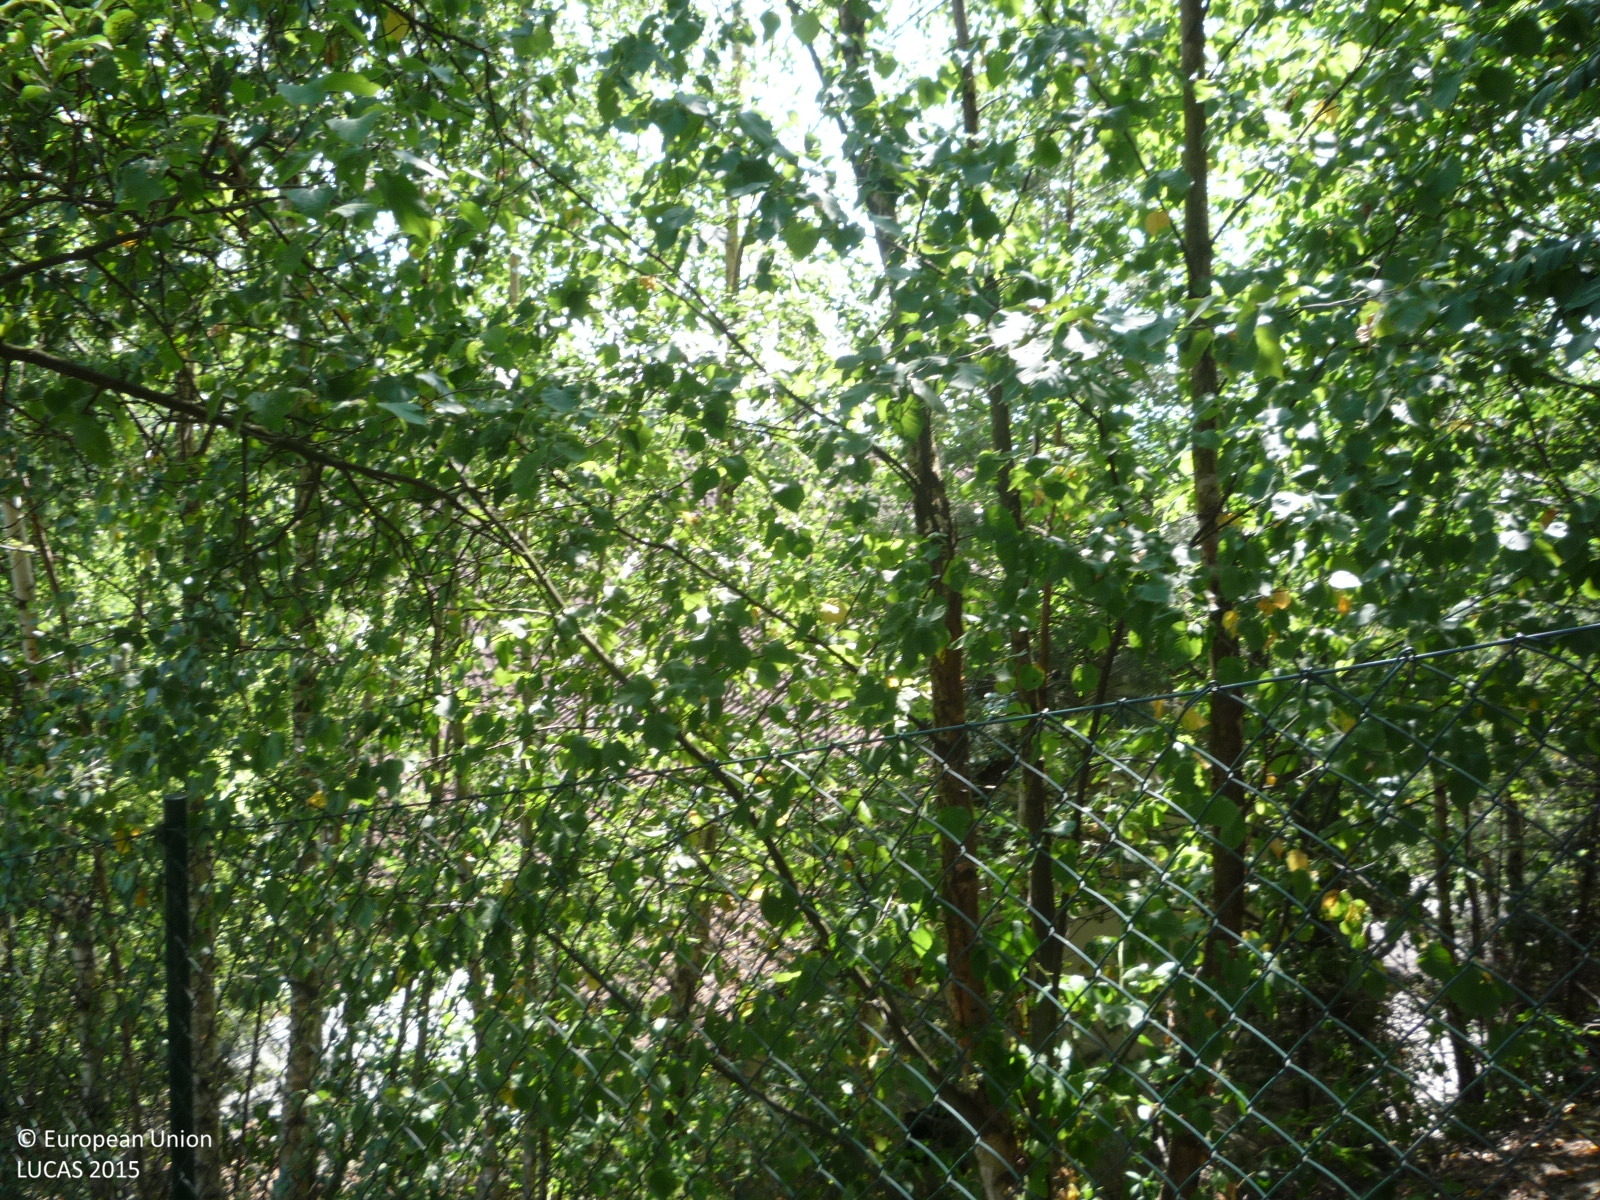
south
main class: Cropland
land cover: Apple fruit
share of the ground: > 75 %
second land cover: Grassland without tree/shrub cover
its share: < 10 %
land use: Kitchen garden
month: August
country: CZ
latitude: 50.5875
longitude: 15.2153
